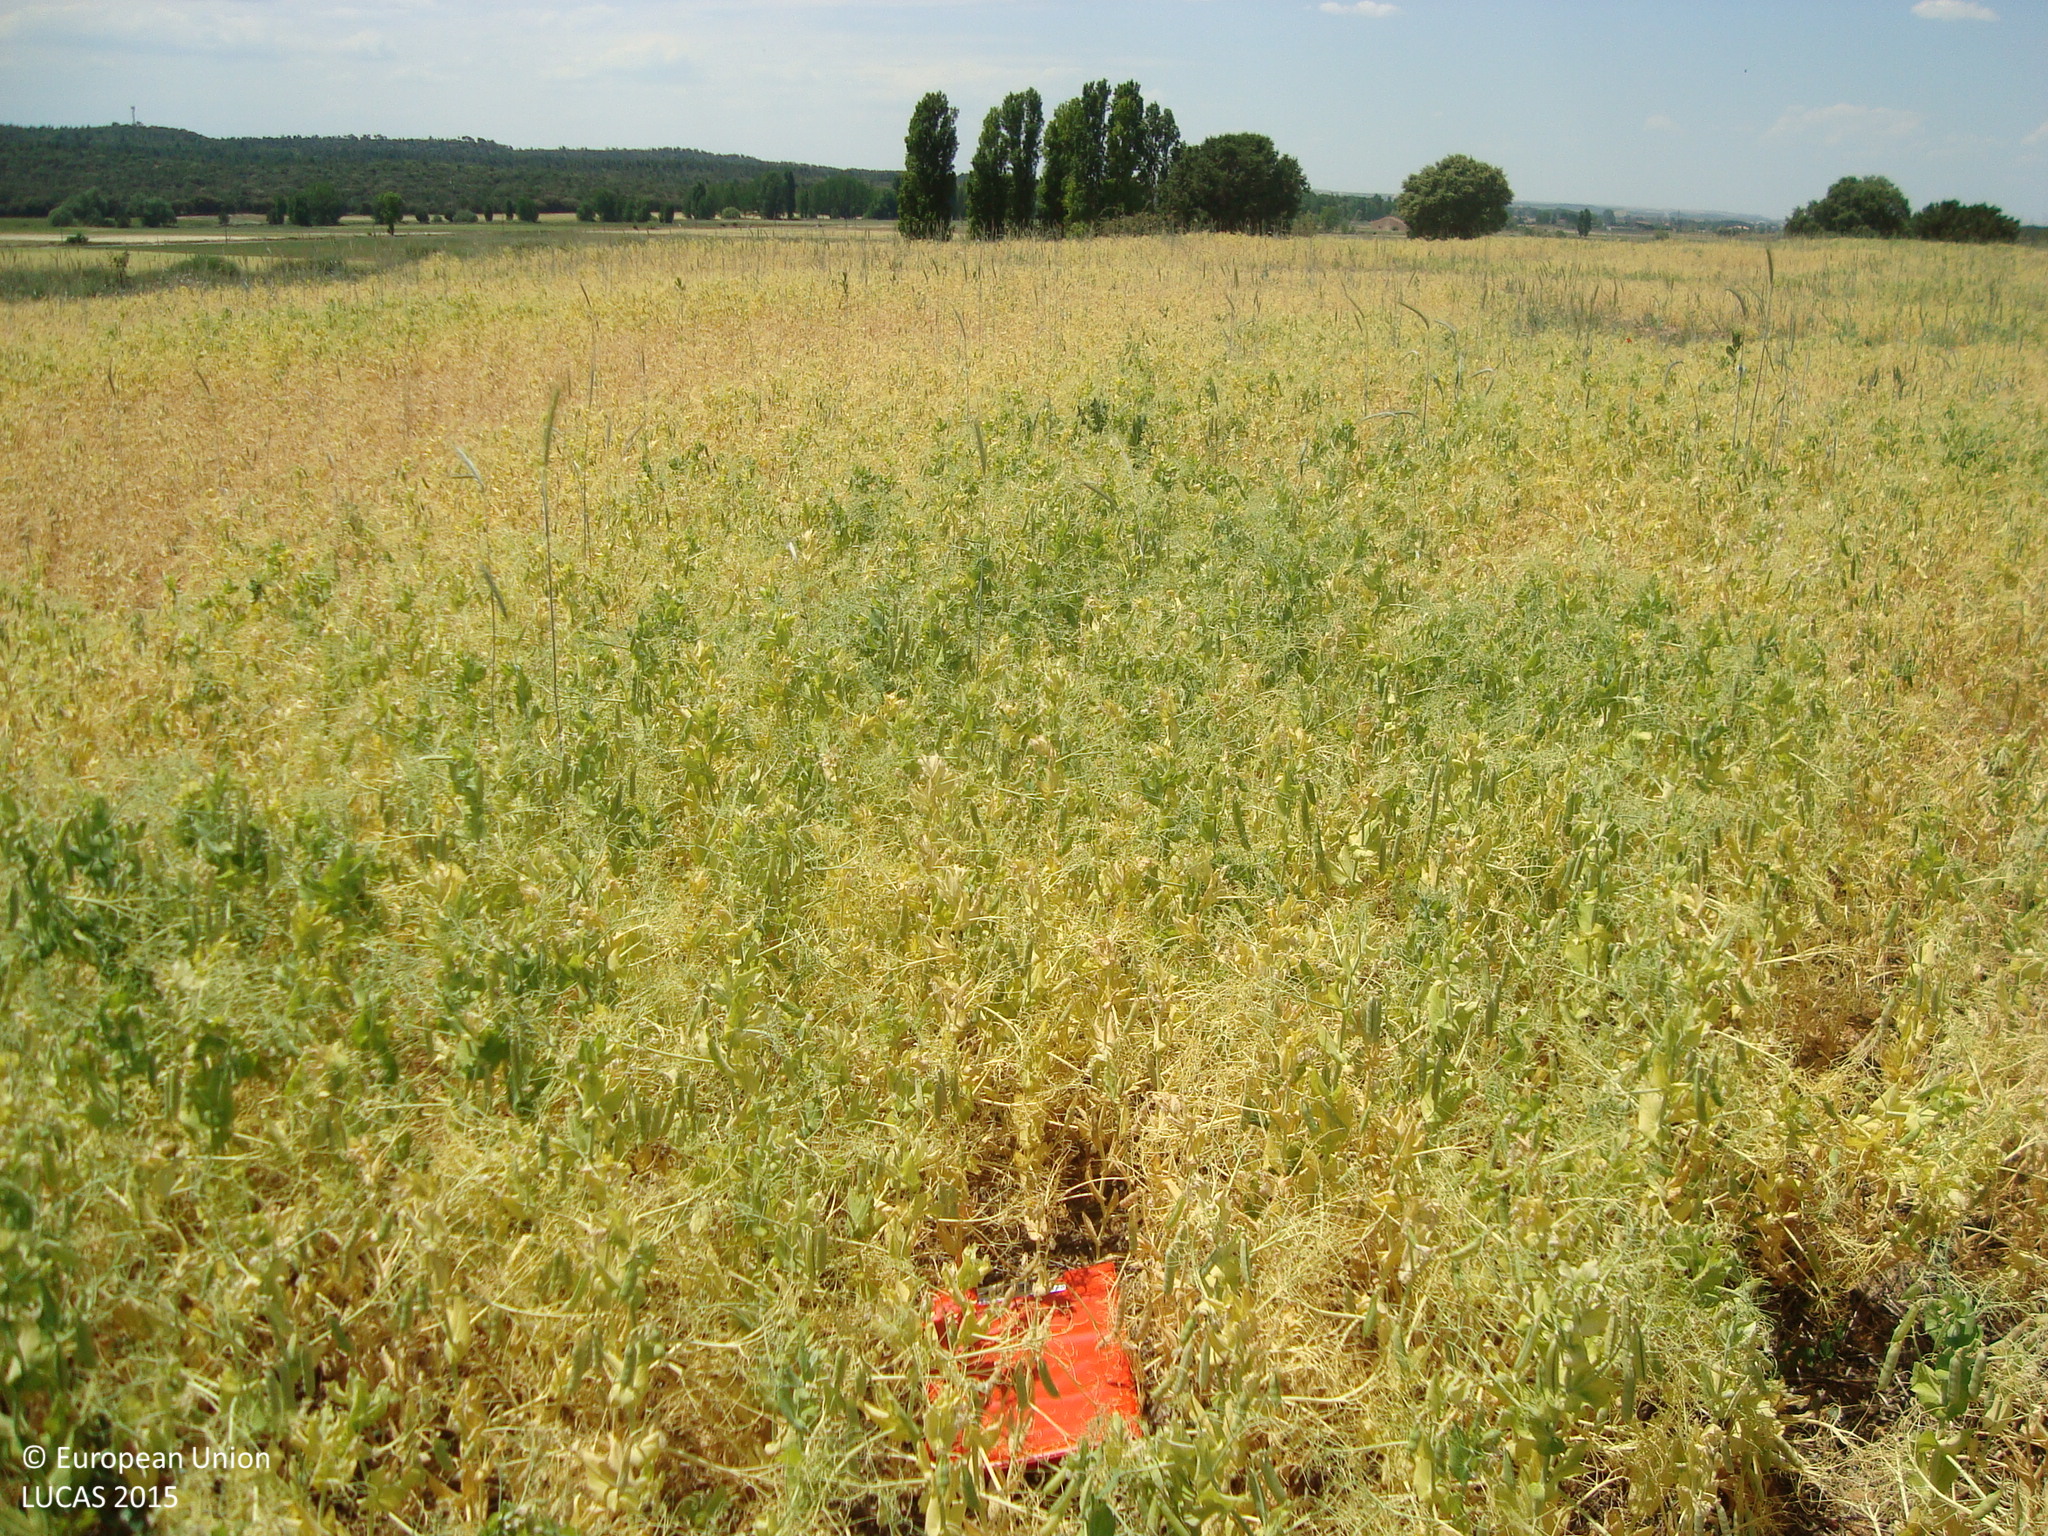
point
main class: Cropland
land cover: Dry pulses
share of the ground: > 75 %
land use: Agriculture (excluding fallow land and kitchen gardens)
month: June
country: ES
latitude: 41.6962
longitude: -3.5935
